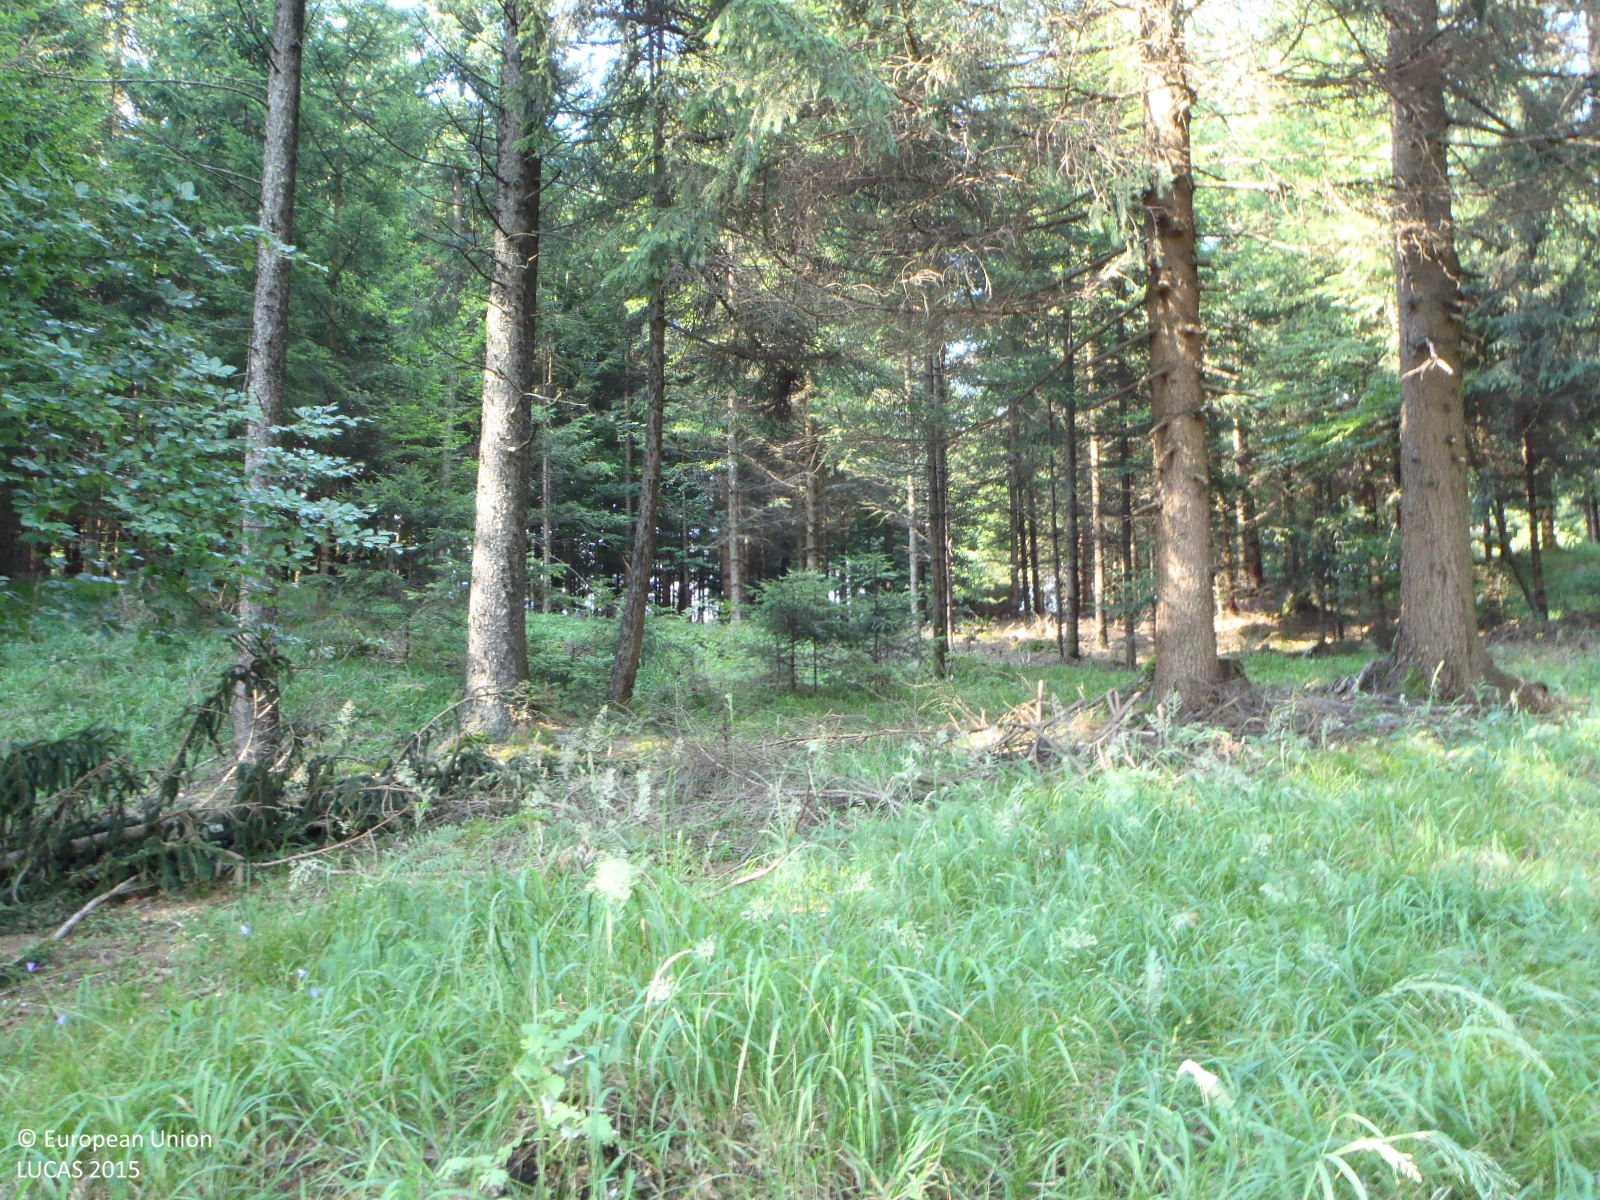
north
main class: Woodland
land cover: Spruce dominated mixed woodland
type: alpine coniferous forest
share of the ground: > 75 %
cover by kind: coniferous forest trees 70 %, broadleaved forest trees 25 %, herbaceous plants 5 %
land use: Forestry
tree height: > 5 m
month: July
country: AT
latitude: 47.4331
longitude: 11.8945
